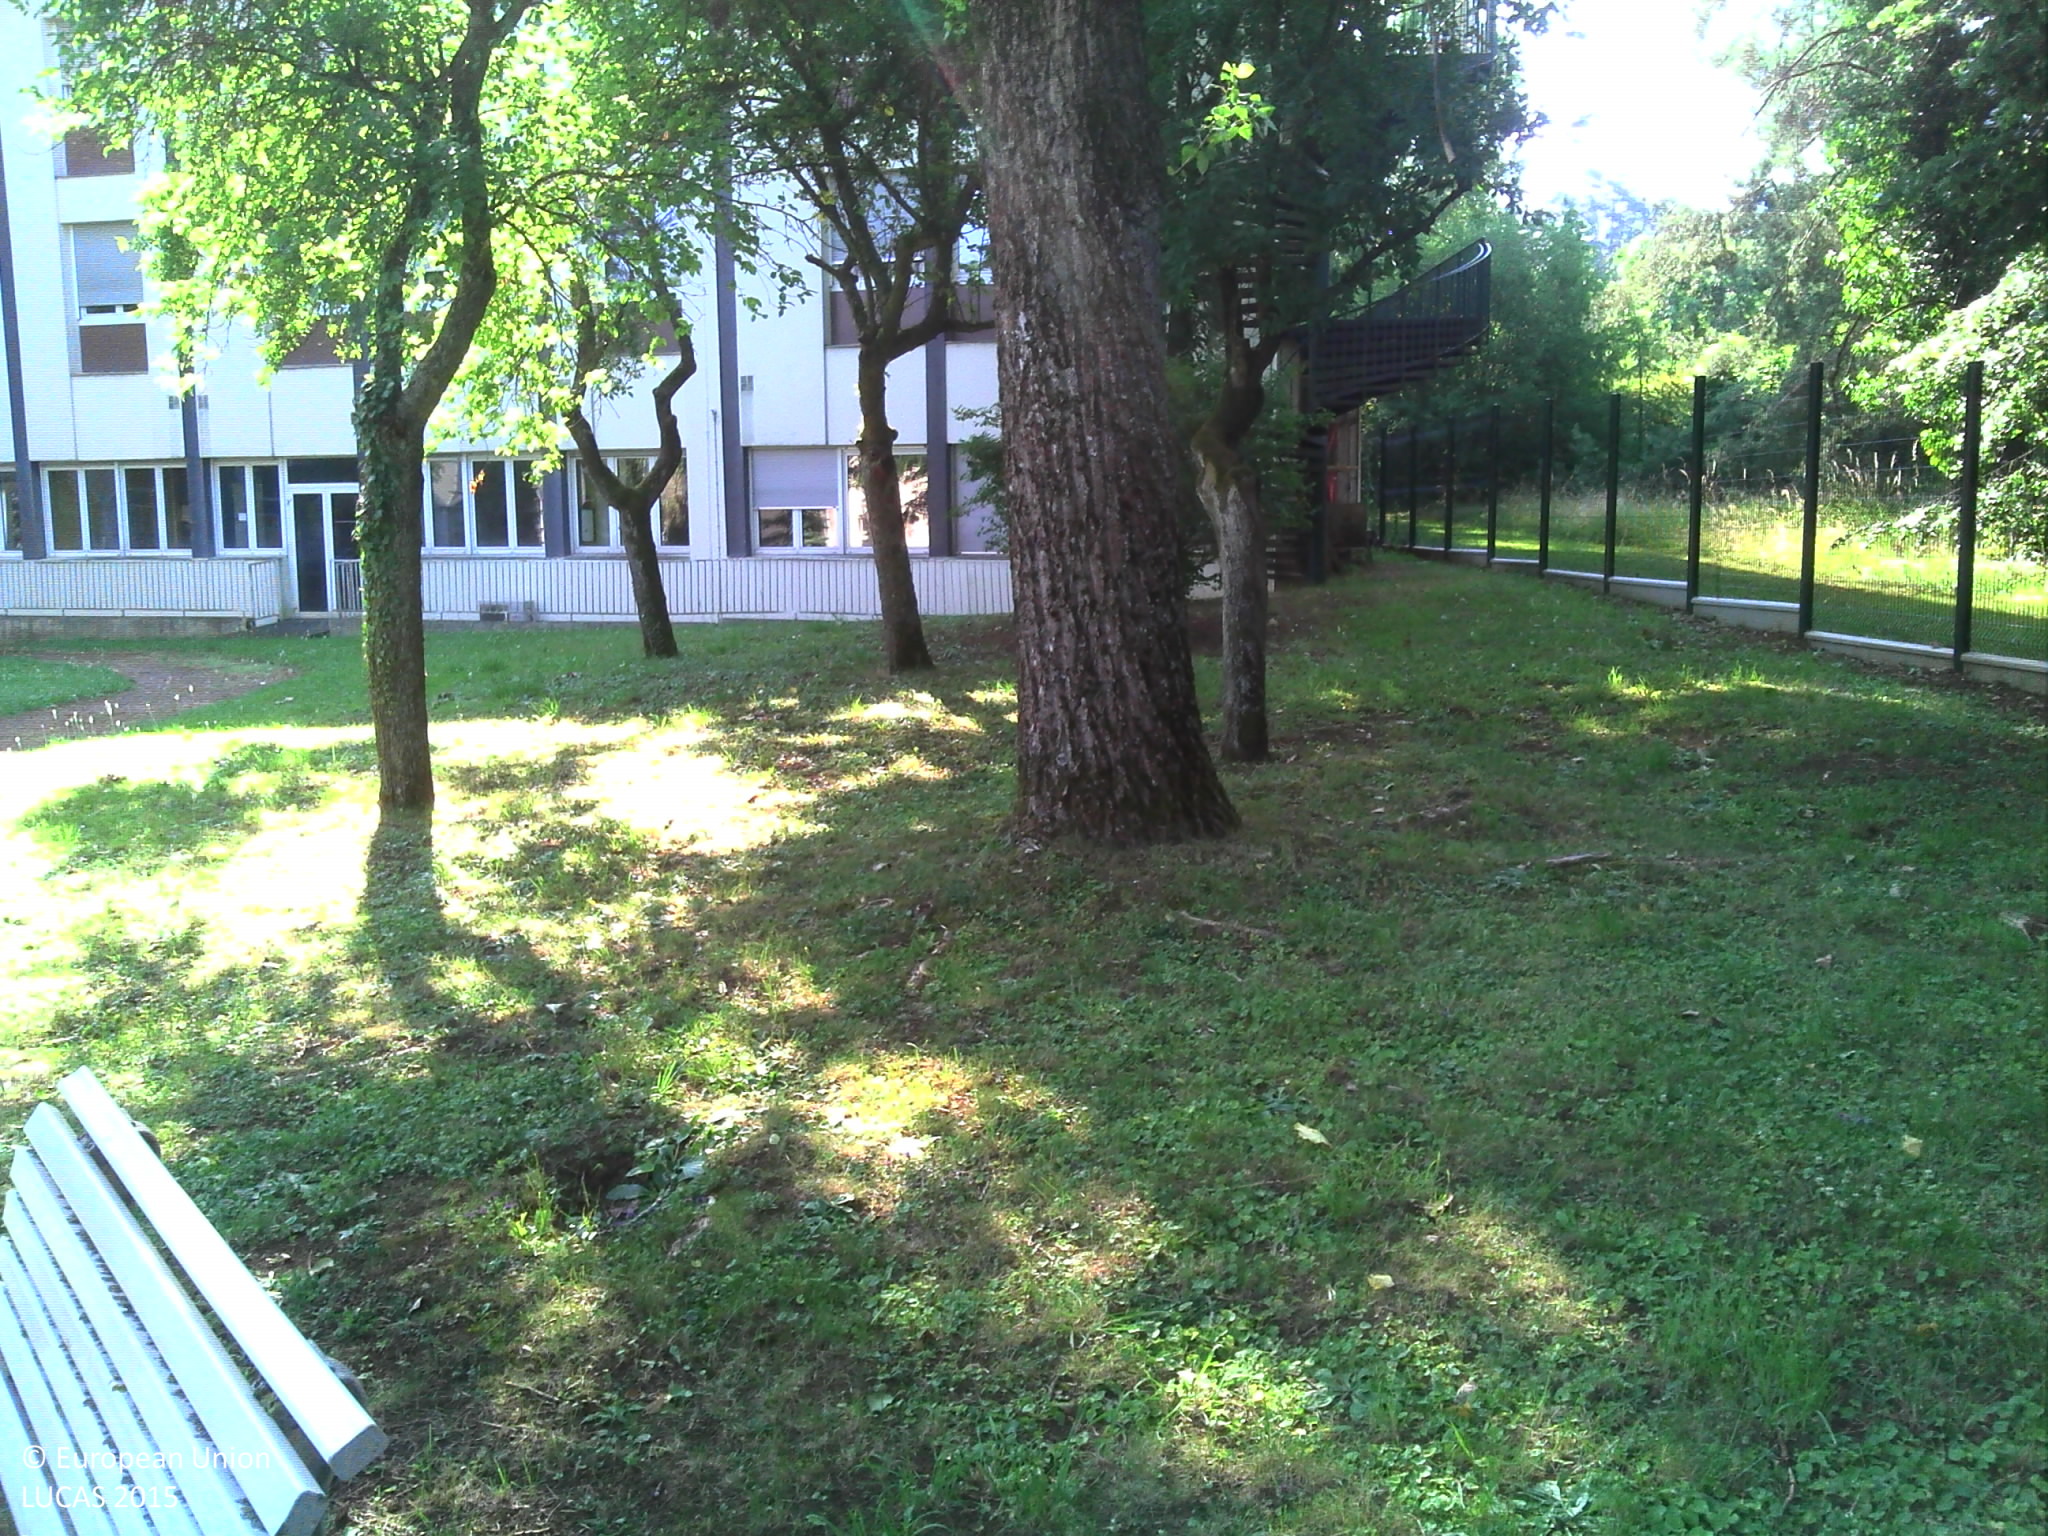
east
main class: Woodland
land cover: Broadleaved woodland
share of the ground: > 75 %
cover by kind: broadleaved forest trees 80 %, herbaceous plants 20 %
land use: Community services
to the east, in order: Broadleaved woodland; Tracks; Broadleaved woodland; Artificial constructions in urban areas
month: July
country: FR
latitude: 48.6610
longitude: 6.1578
